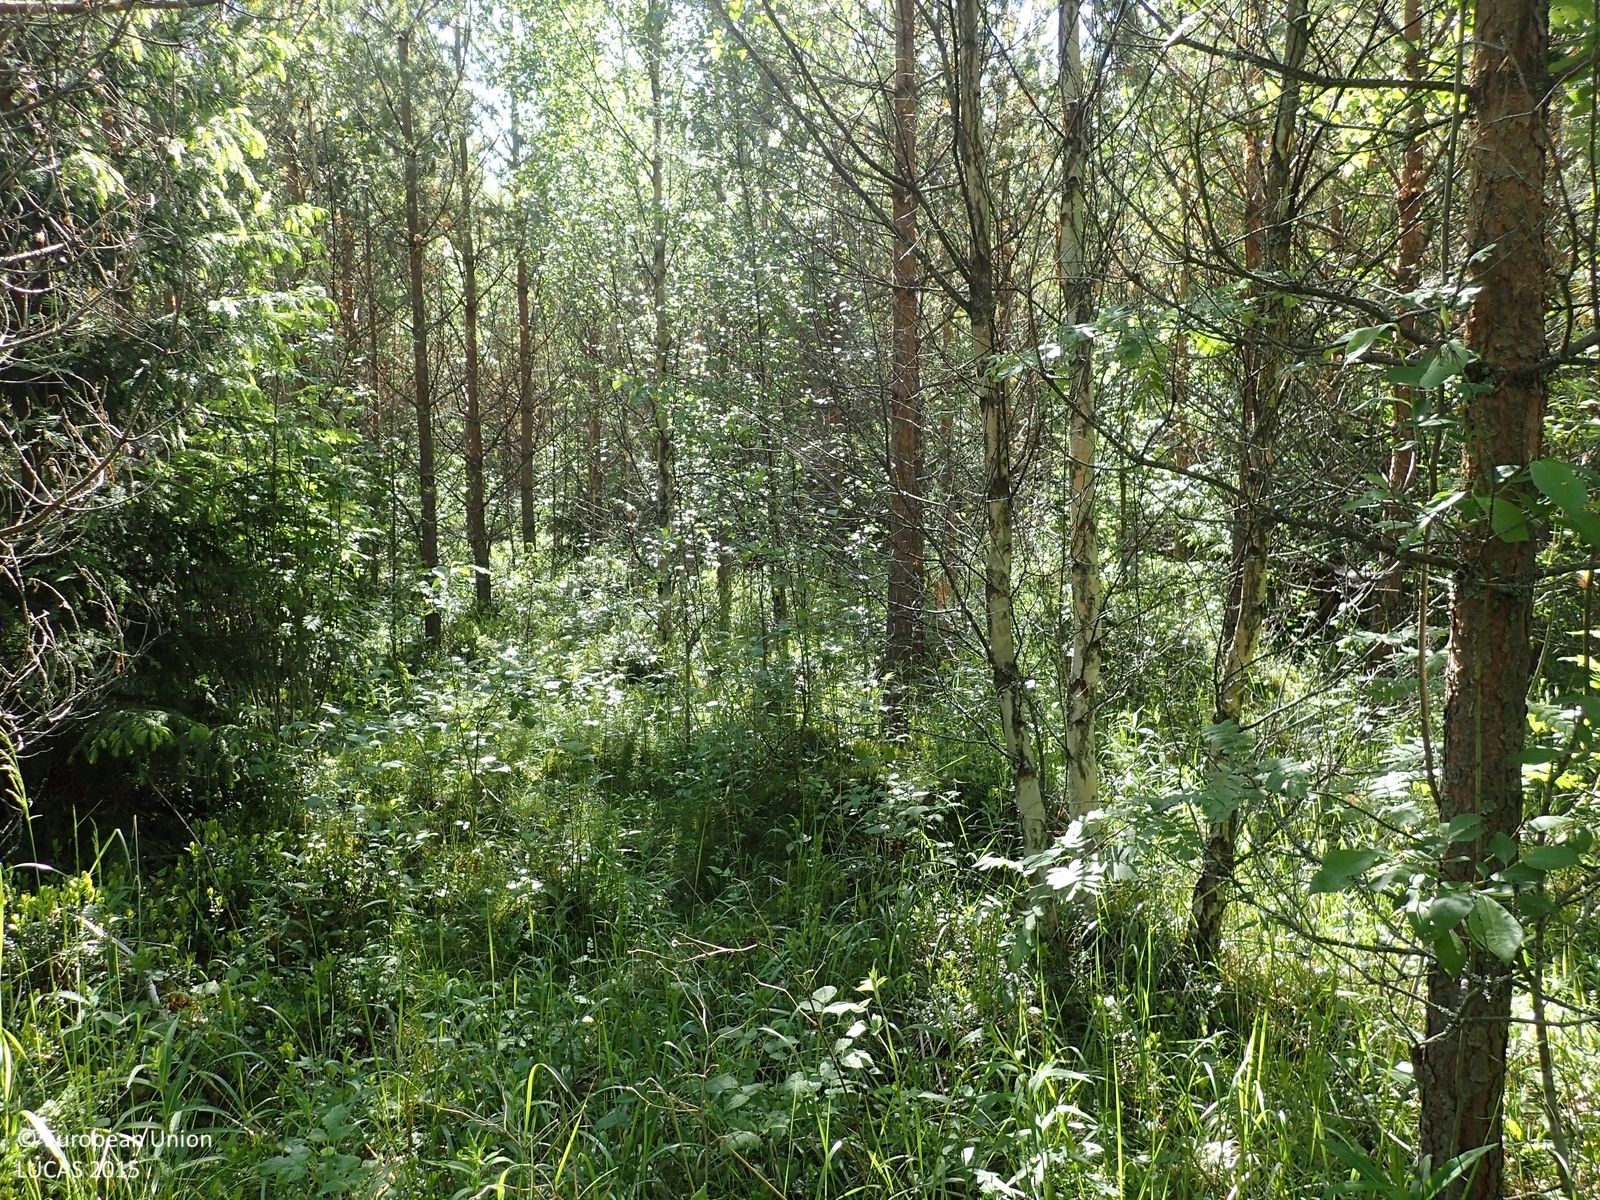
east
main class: Woodland
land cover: Pine dominated mixed woodland
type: boreal forest
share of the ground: > 75 %
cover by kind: coniferous forest trees 60 %, broadleaved forest trees 25 %, herbaceous plants 15 %
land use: Forestry
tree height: > 5 m
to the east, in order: Pine dominated mixed woodland; Ditches and canals; Broadleaved woodland; Ditches and canals; Shruby margins; Paved roads, cycling and walking lanes; Grass margins; Ditches and canals; Shruby margins; Electric lines; Shruby margins; Artificial constructions in urban areas; Broadleaved woodland; Electric lines; Broadleaved woodland
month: June
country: FI
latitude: 62.4000
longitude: 21.3611
